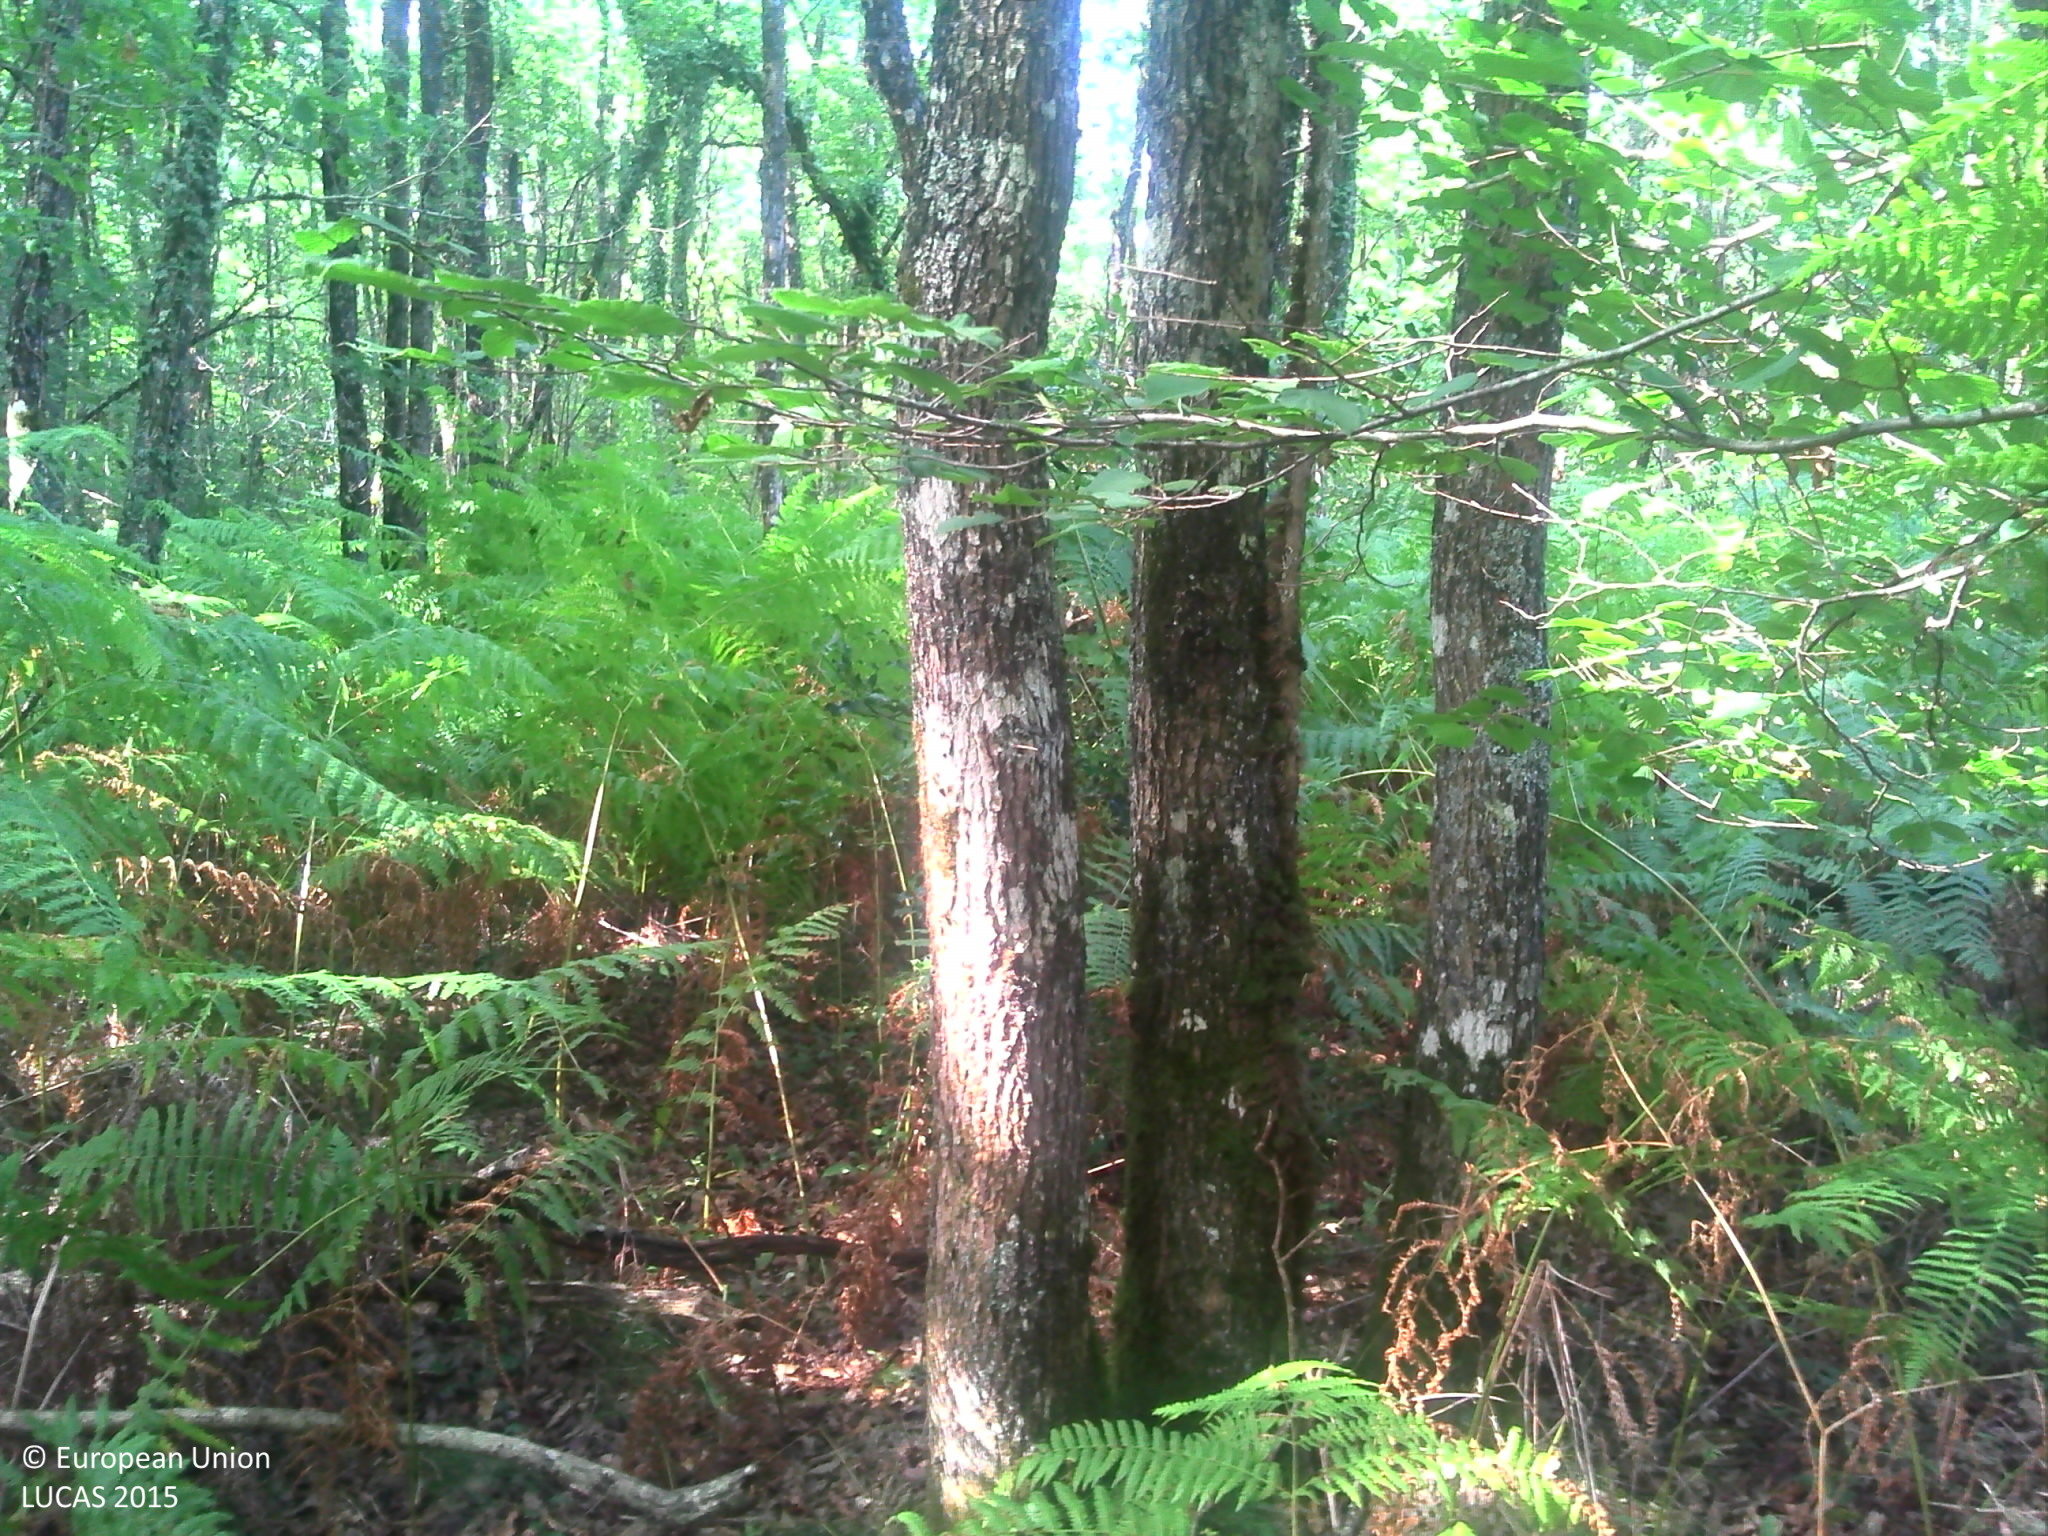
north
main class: Woodland
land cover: Broadleaved woodland
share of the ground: > 75 %
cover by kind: broadleaved forest trees 95 %, coniferous forest trees 5 %
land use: Semi-natural and natural areas not in use
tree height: > 5 m
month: August
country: FR
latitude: 46.0978
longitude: 0.9980
